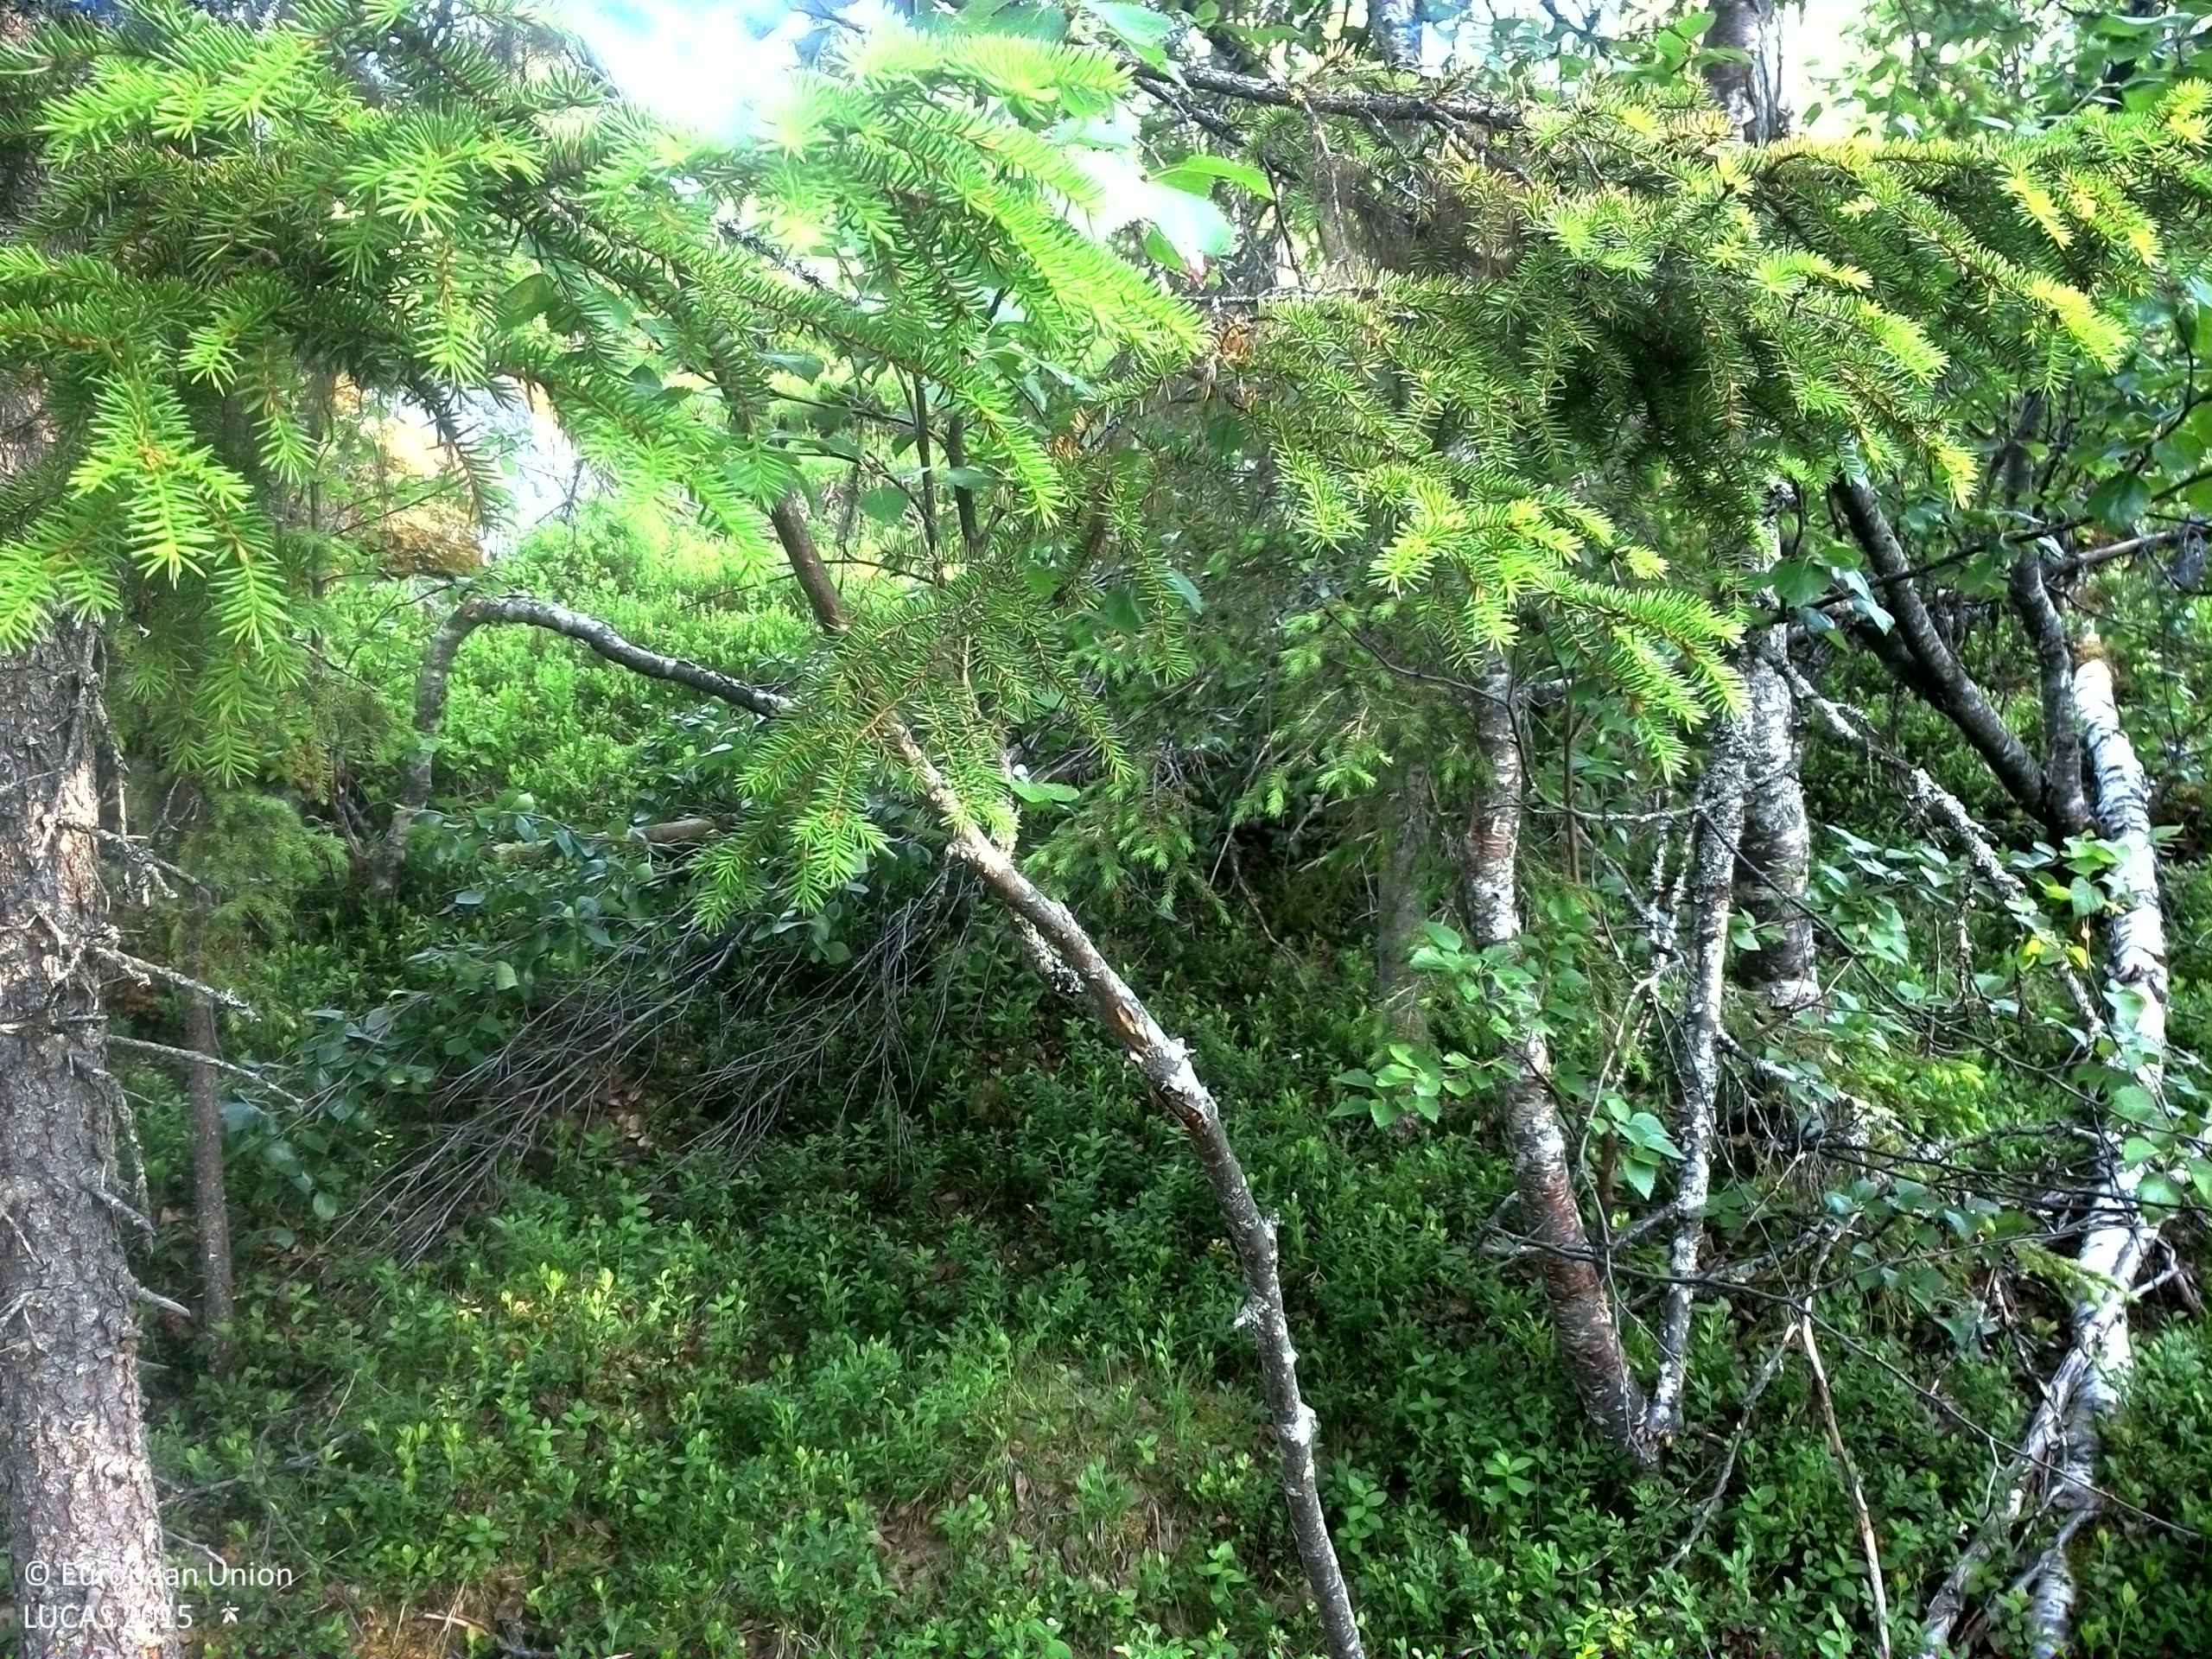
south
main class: Woodland
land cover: Spruce dominated mixed woodland
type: boreal forest
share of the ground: 25 - 50 %
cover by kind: shrubs 35 %, coniferous forest trees 30 %, broadleaved forest trees 15 %, herbaceous plants 10 %, lichens and mosses 10 %
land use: Forestry
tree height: > 5 m
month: July
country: SE
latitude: 64.7432
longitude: 15.3257
